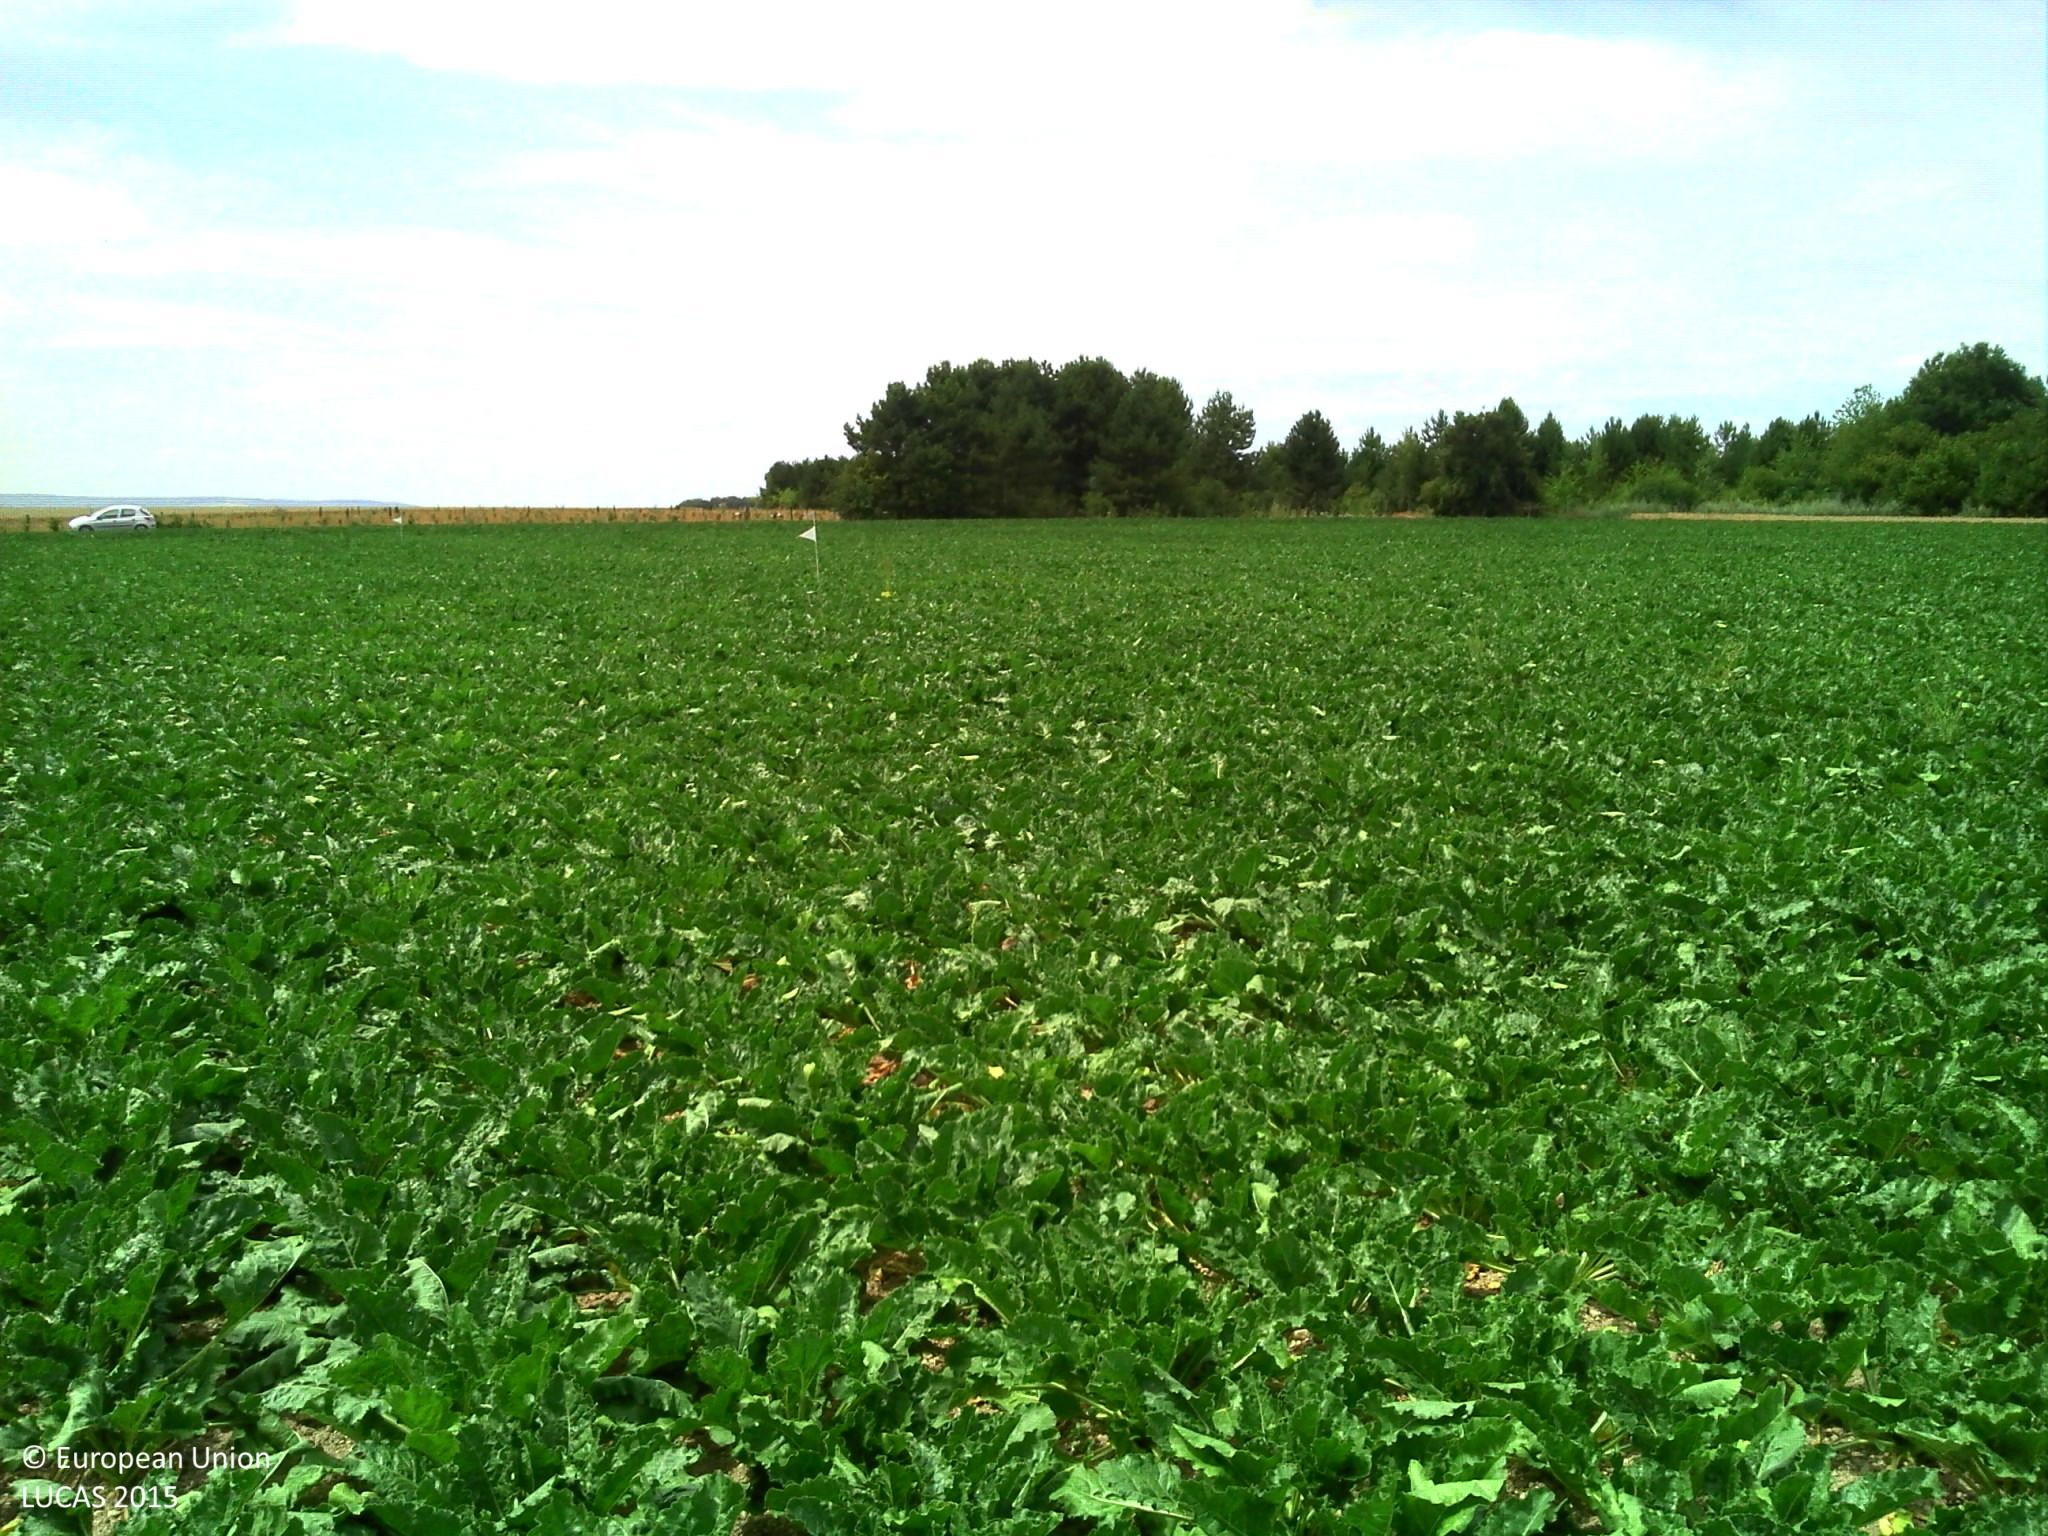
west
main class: Cropland
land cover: Sugar beet
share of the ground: > 75 %
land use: Agriculture (excluding fallow land and kitchen gardens)
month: July
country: FR
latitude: 49.4024
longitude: 4.1385
